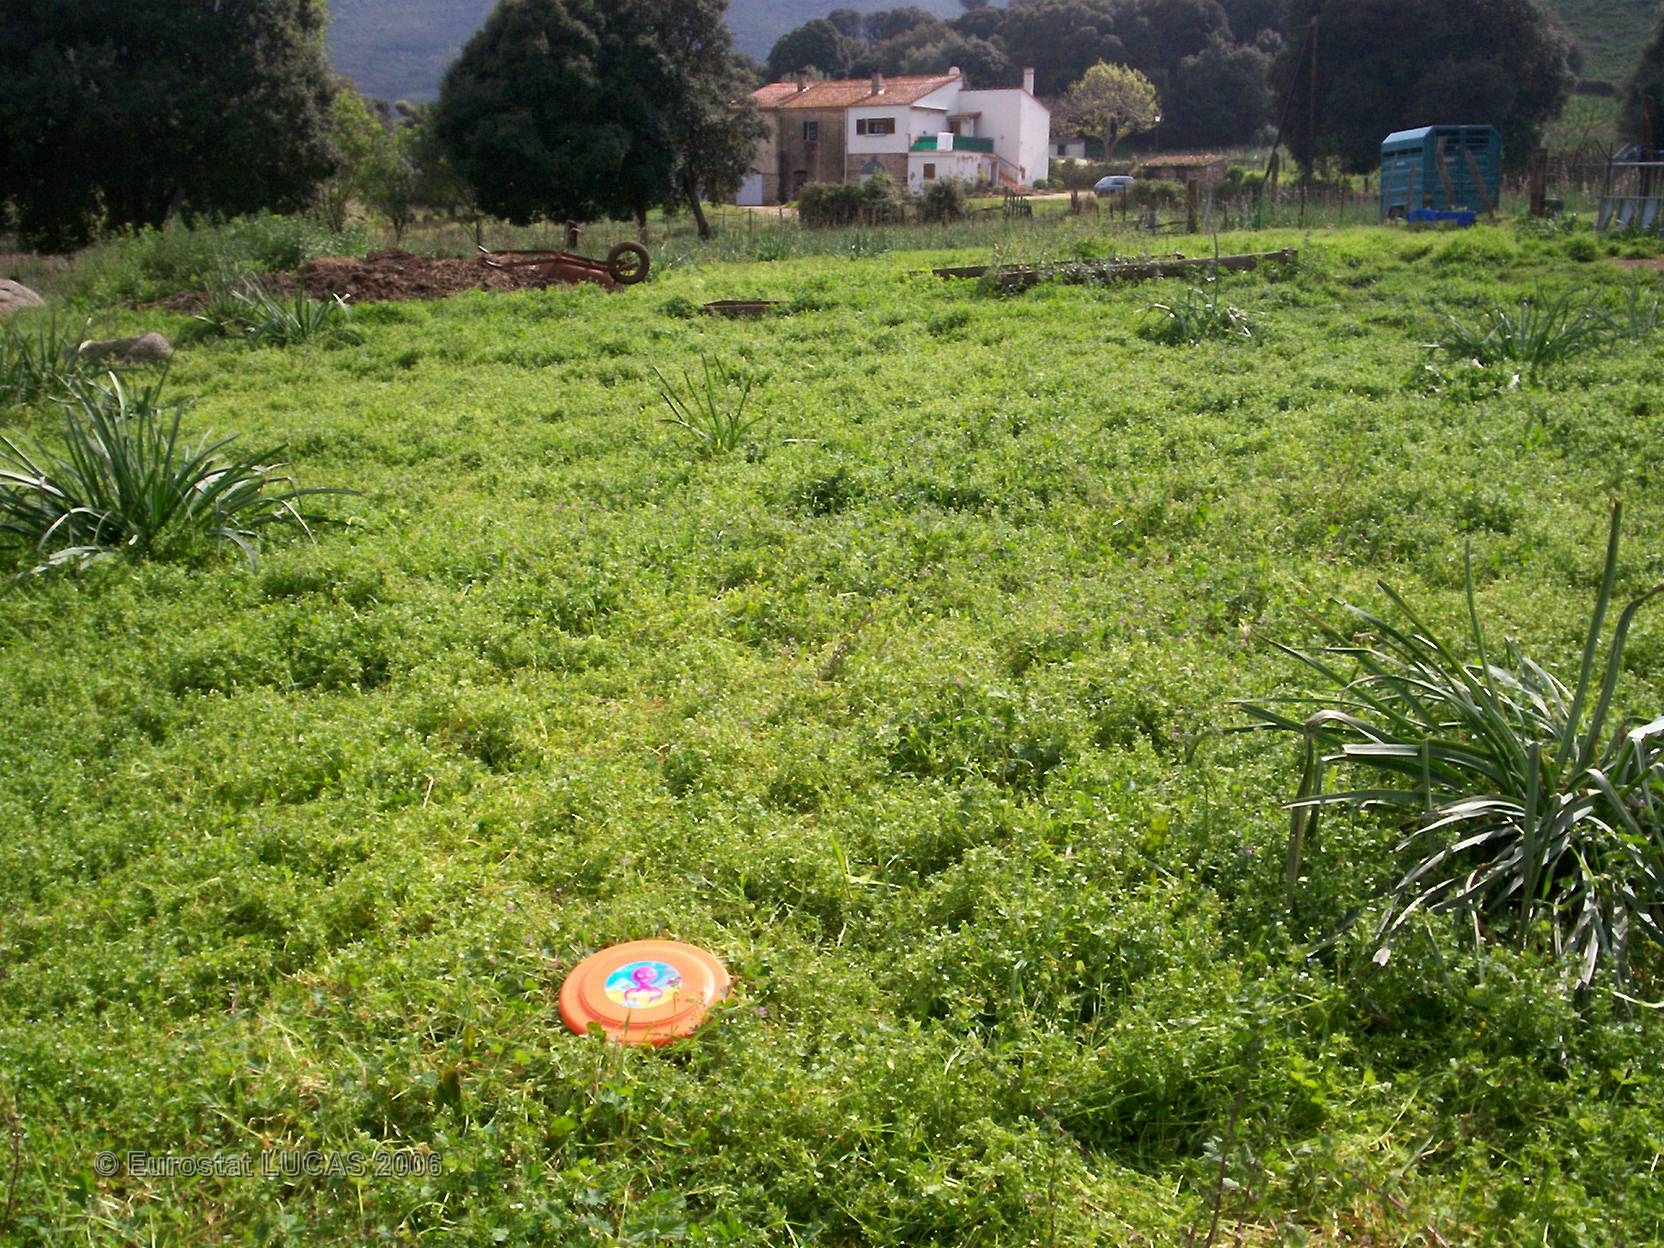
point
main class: Grassland
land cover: Grassland without tree/shrub cover
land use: Agriculture (excluding fallow land and kitchen gardens)
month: April
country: FR
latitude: 41.9960
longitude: 8.7613
